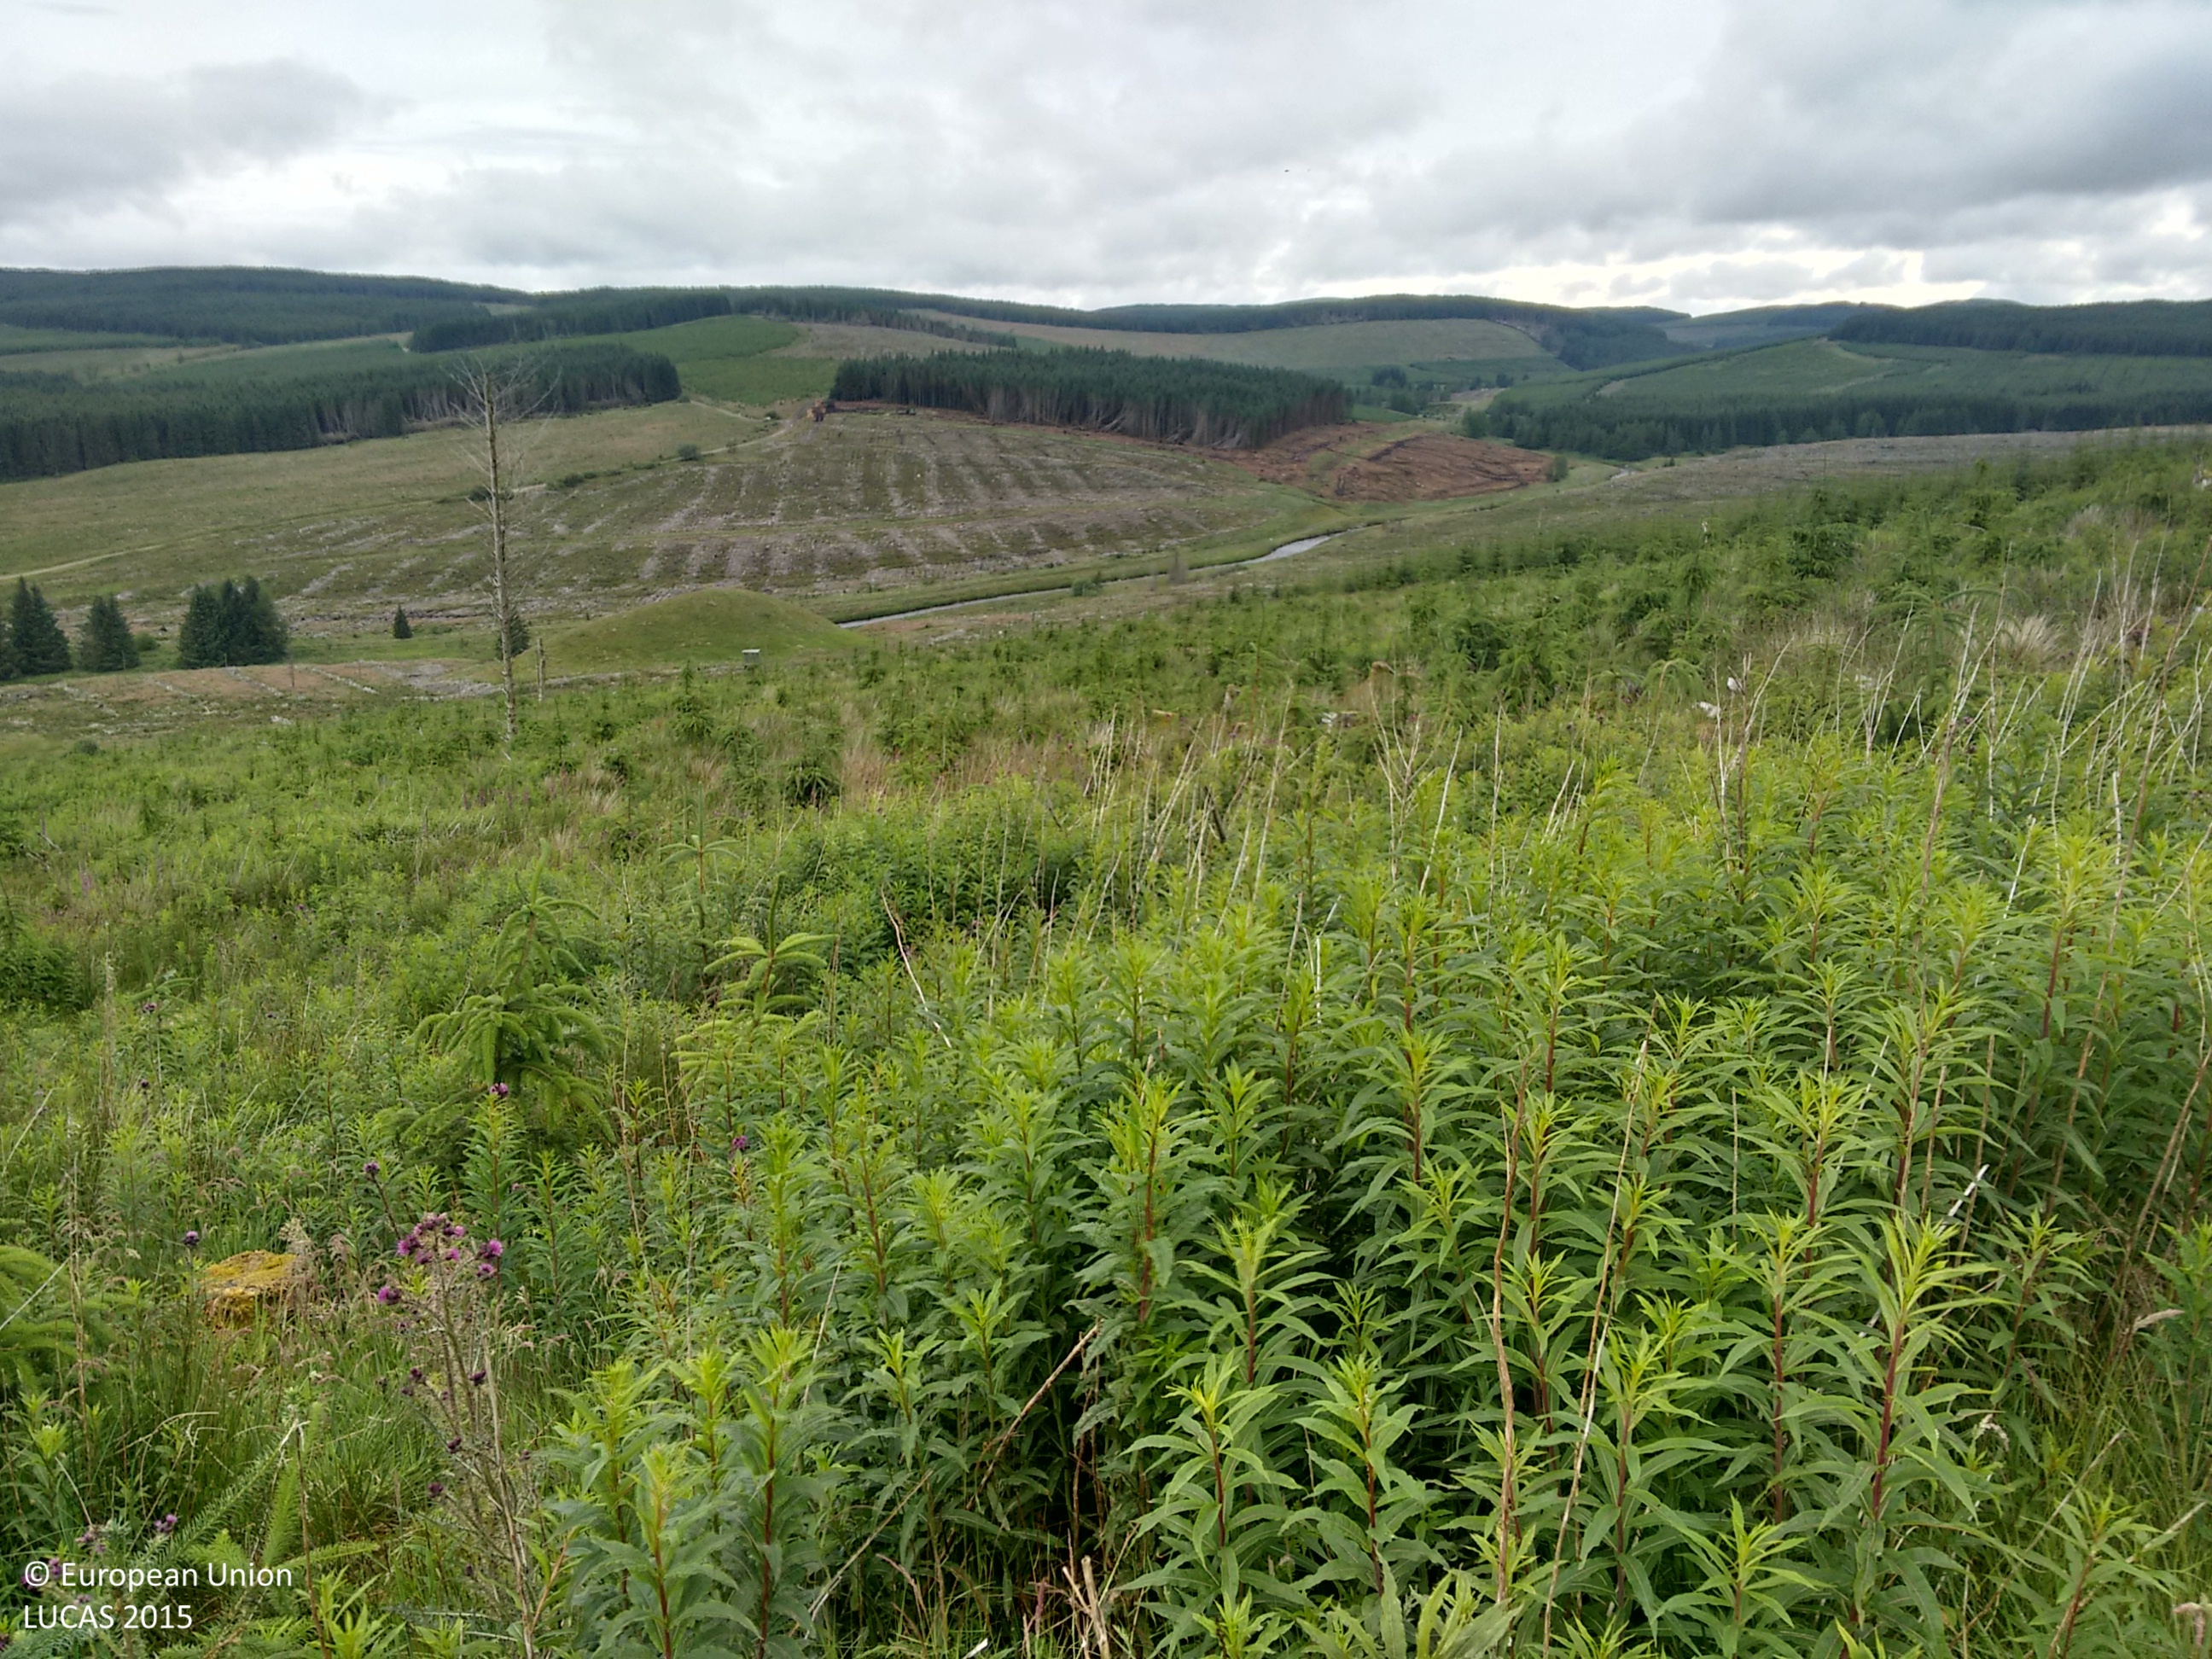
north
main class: Woodland
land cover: Spruce dominated coniferous woodland
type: exotic forest
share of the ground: 10 - 25 %
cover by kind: herbaceous plants 80 %, coniferous forest trees 15 %, shrubs 5 %
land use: Forestry
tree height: < 5 m
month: July
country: GB
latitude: 55.2738
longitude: -4.2781
